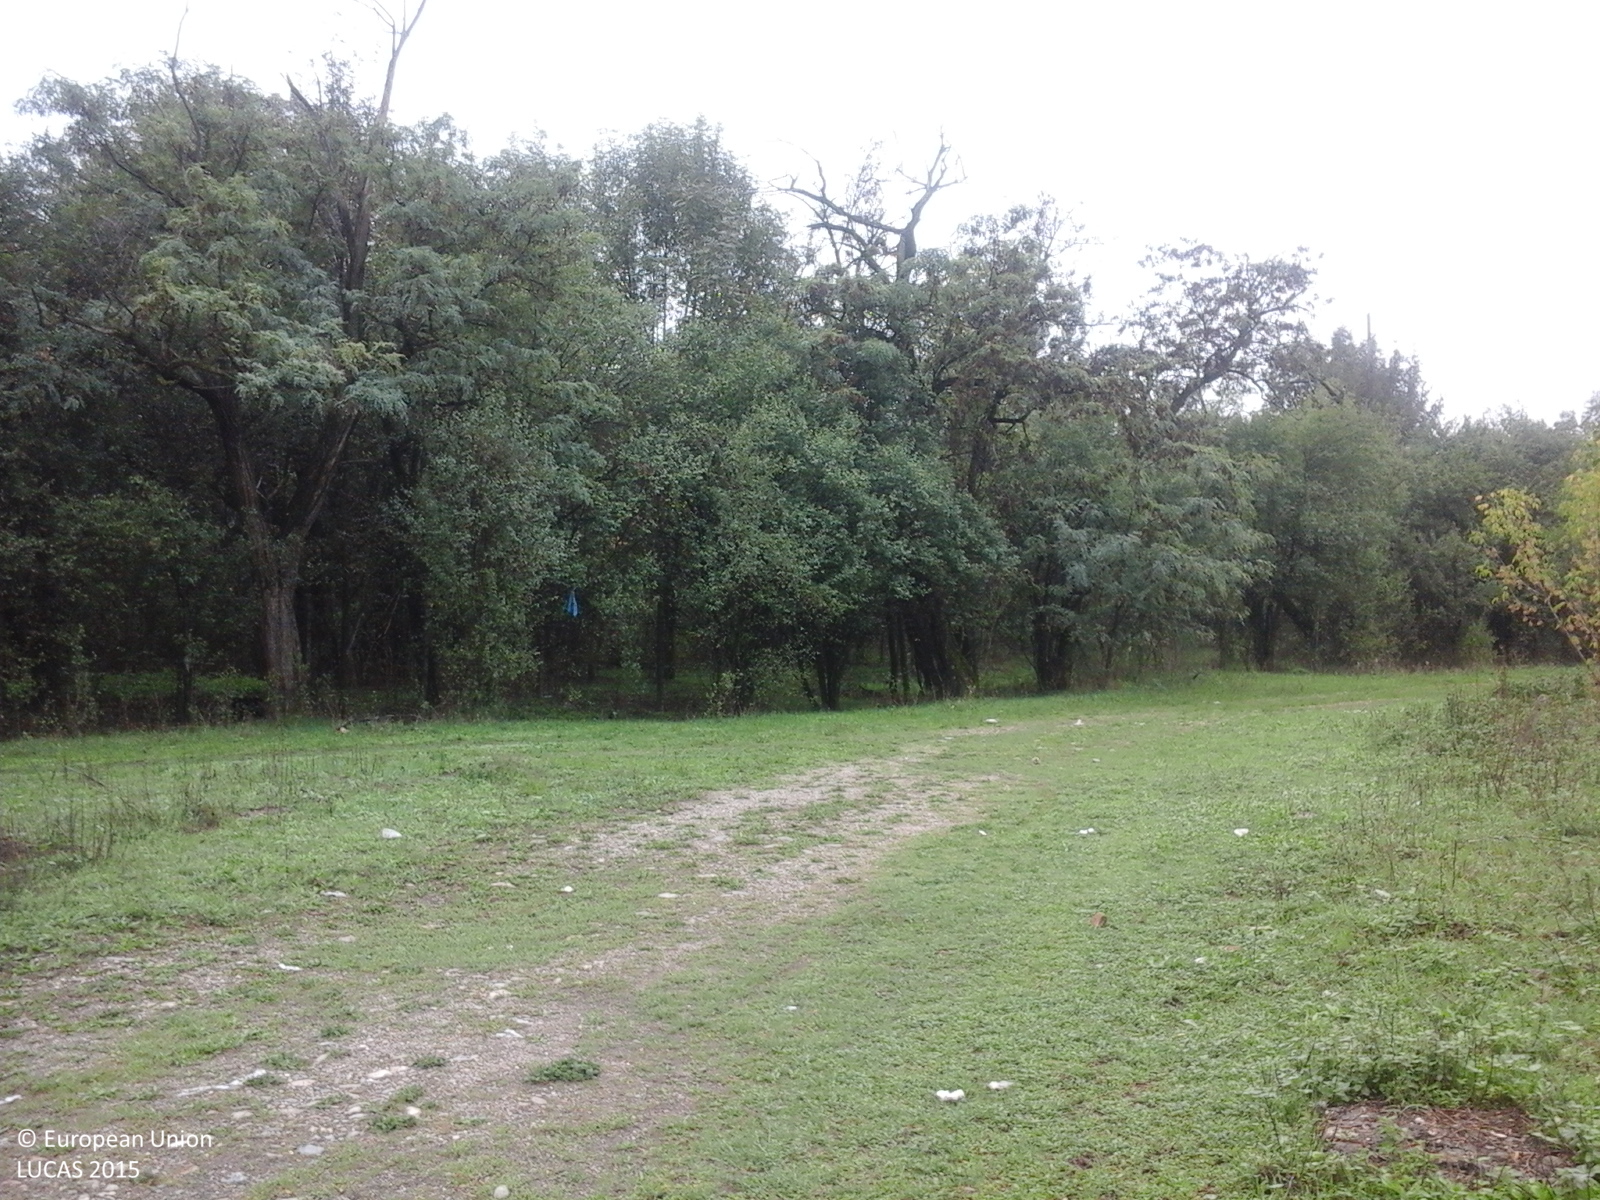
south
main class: Grassland
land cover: Grassland without tree/shrub cover
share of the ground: > 75 %
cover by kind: herbaceous plants 100 %
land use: Agriculture (excluding fallow land and kitchen gardens)
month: September
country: RO
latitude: 45.0424
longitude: 23.2954
